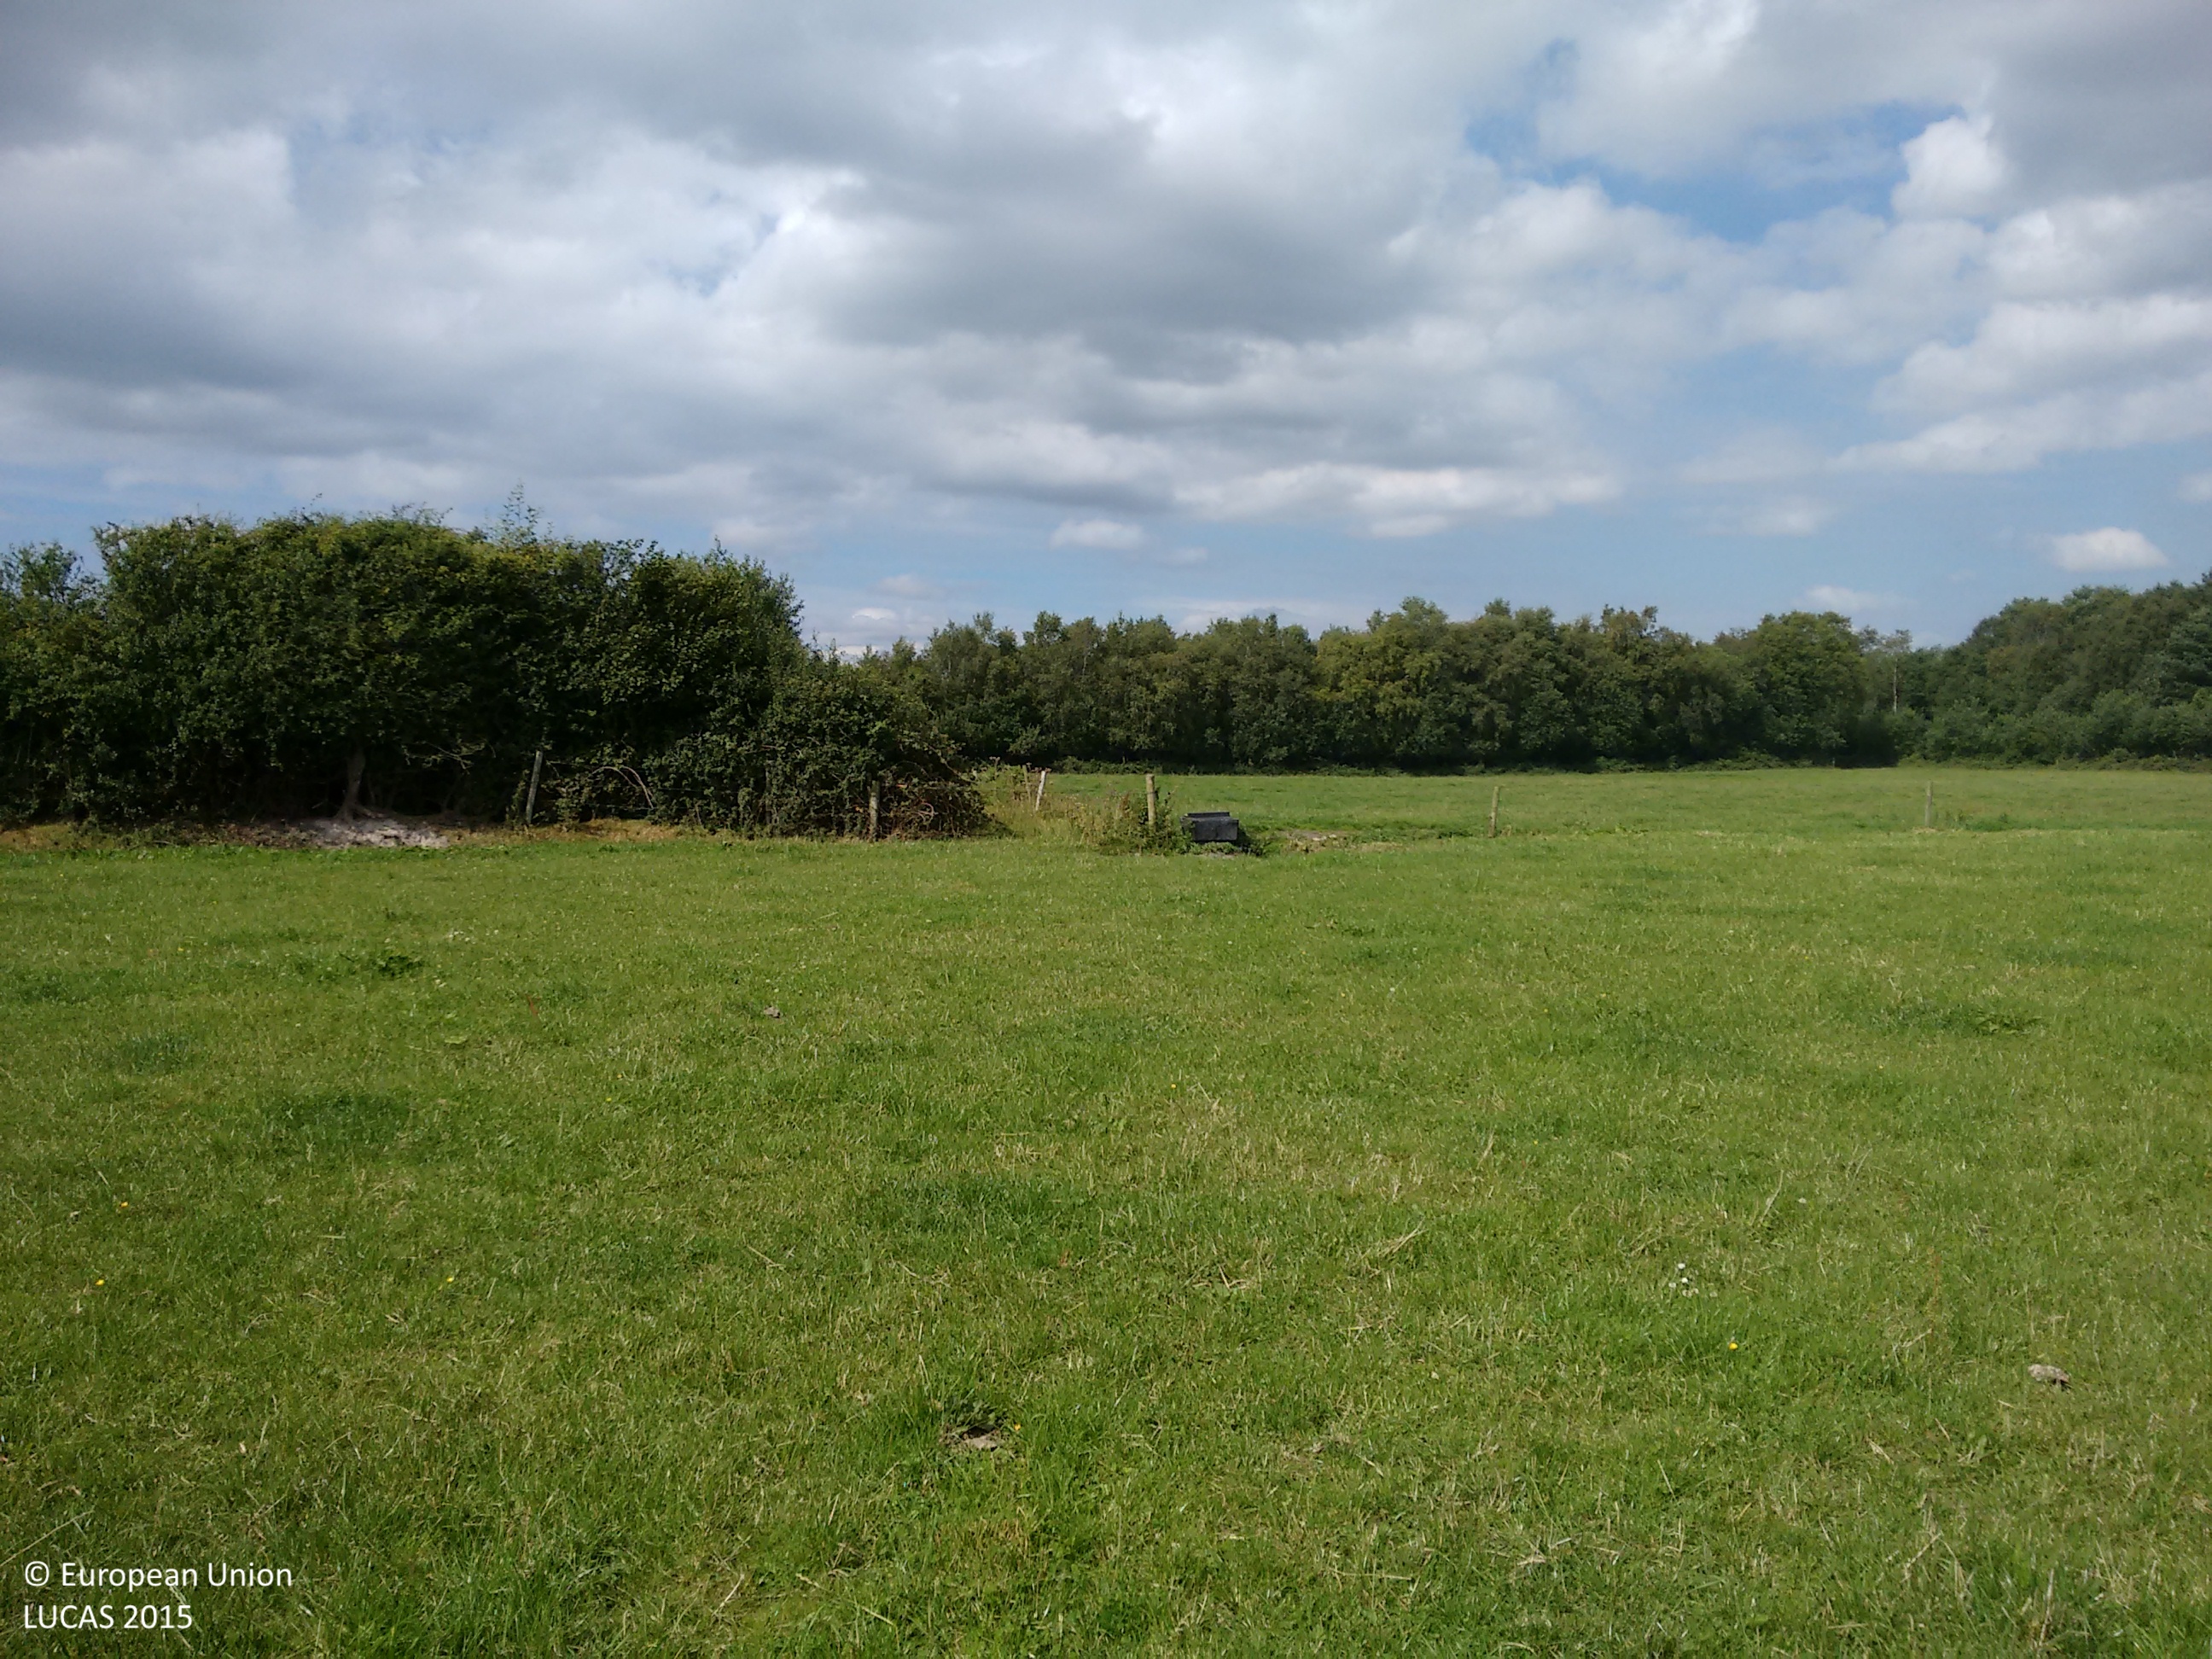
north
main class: Grassland
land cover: Grassland without tree/shrub cover
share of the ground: > 75 %
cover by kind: herbaceous plants 100 %
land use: Agriculture (excluding fallow land and kitchen gardens)
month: August
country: IE
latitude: 52.9860
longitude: -7.4510
